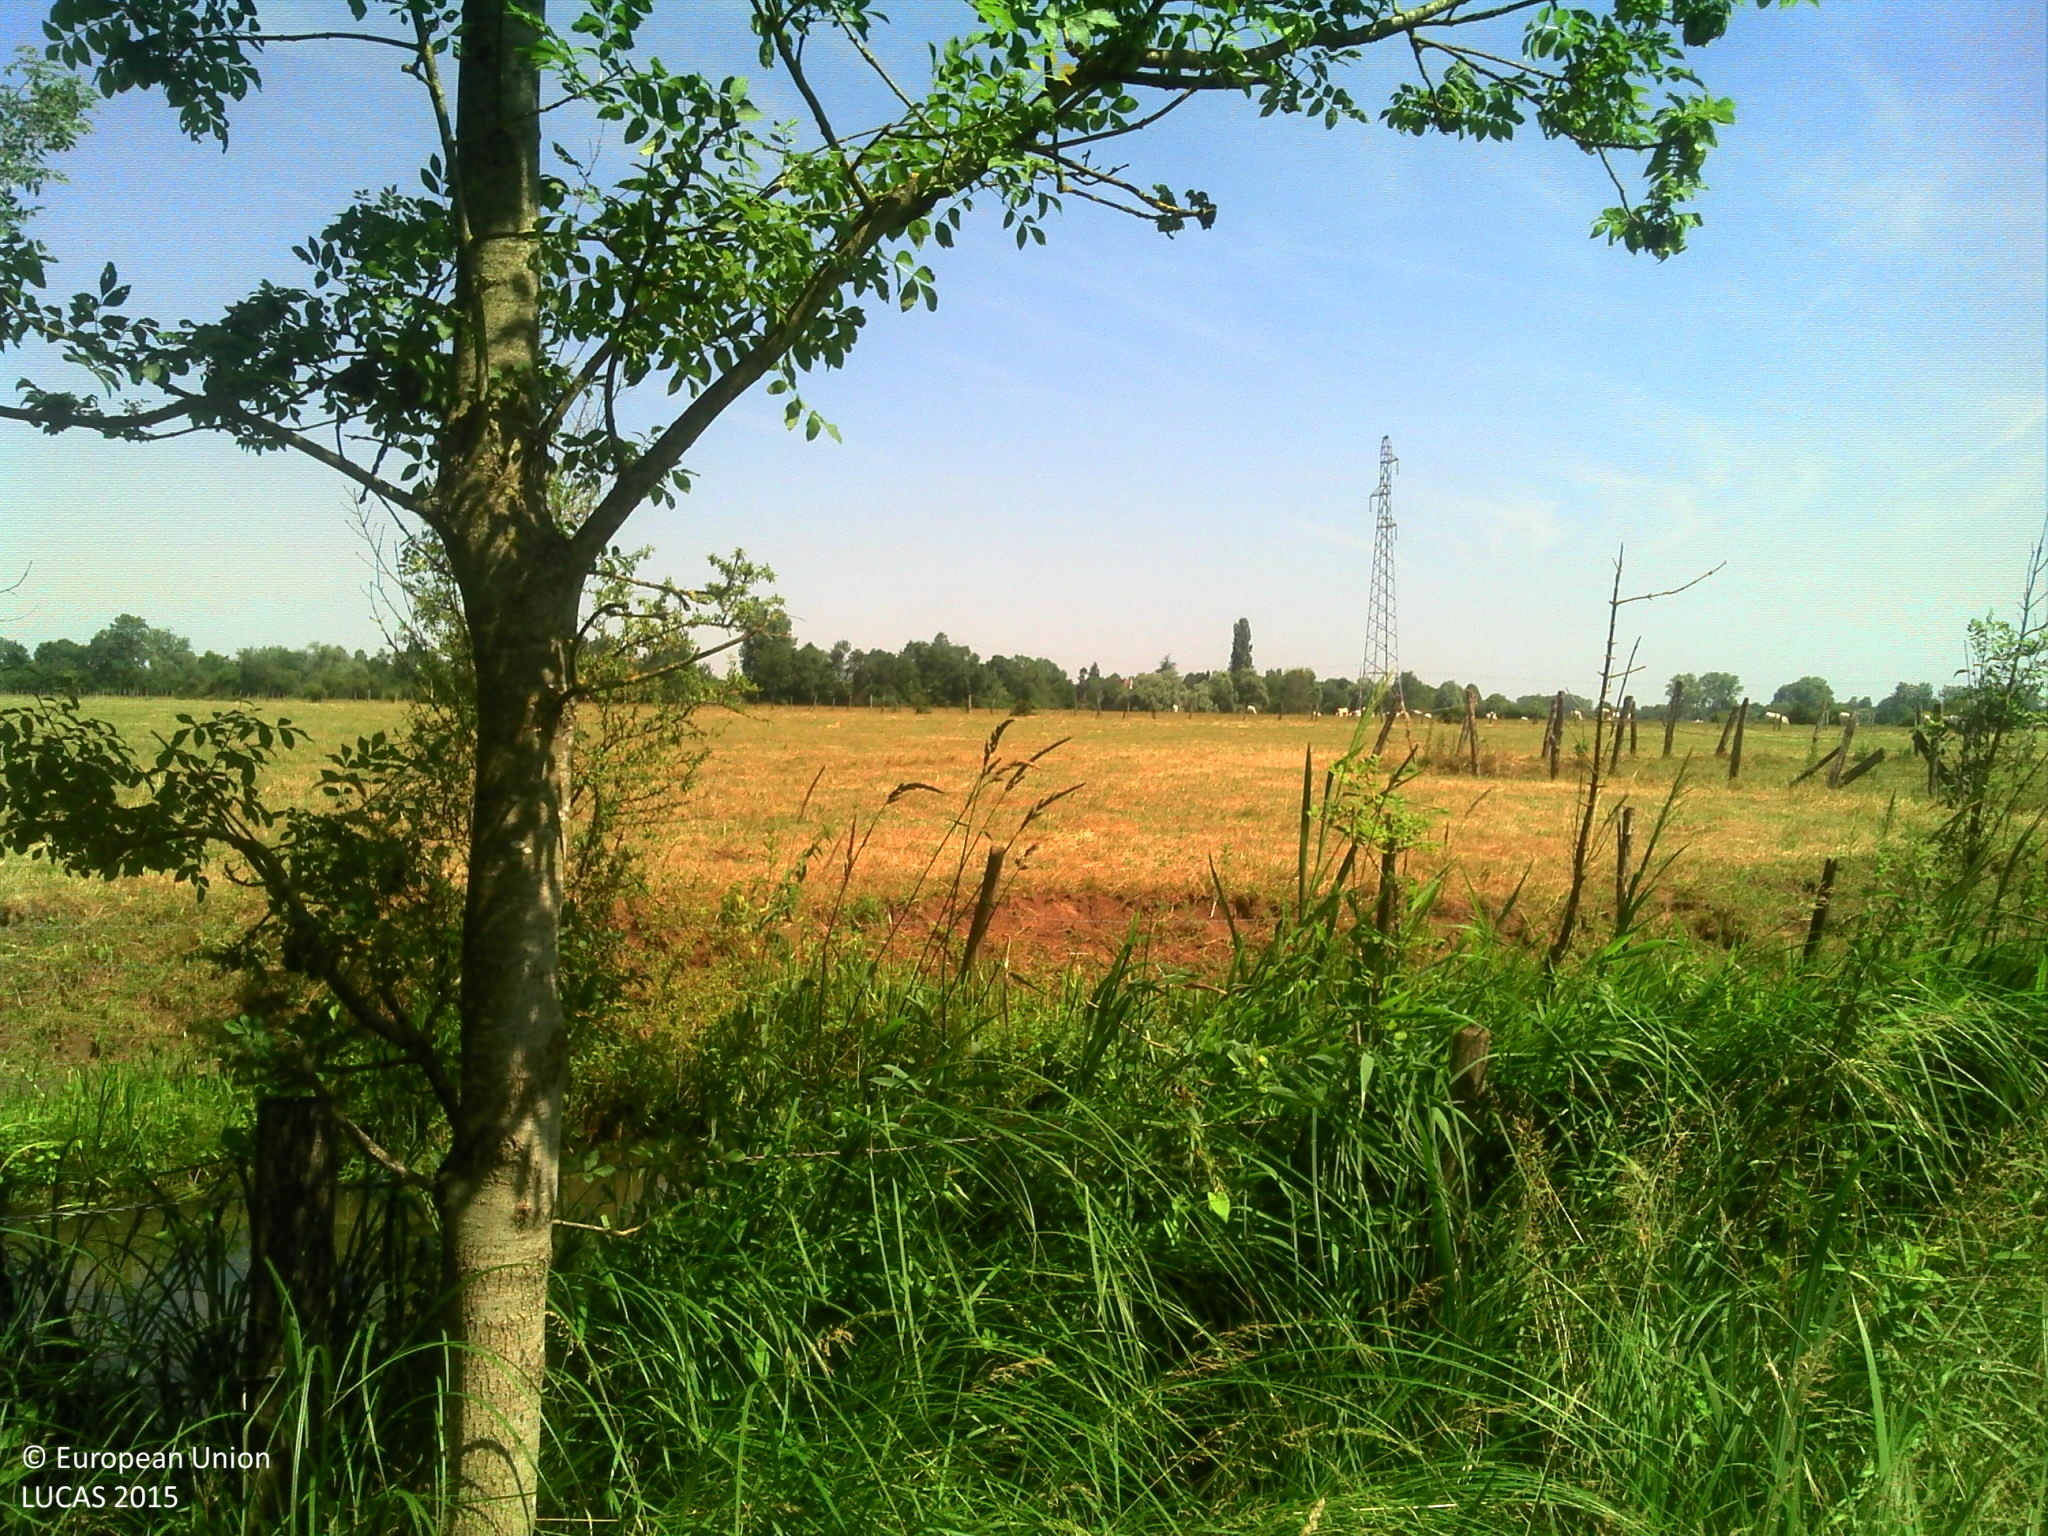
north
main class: Grassland
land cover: Grassland with sparse tree/shrub cover
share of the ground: > 75 %
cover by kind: herbaceous plants 90 %, broadleaved forest trees 5 %, shrubs 5 %
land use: Agriculture (excluding fallow land and kitchen gardens)
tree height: > 5 m
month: June
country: FR
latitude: 47.0945
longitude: 5.2717
